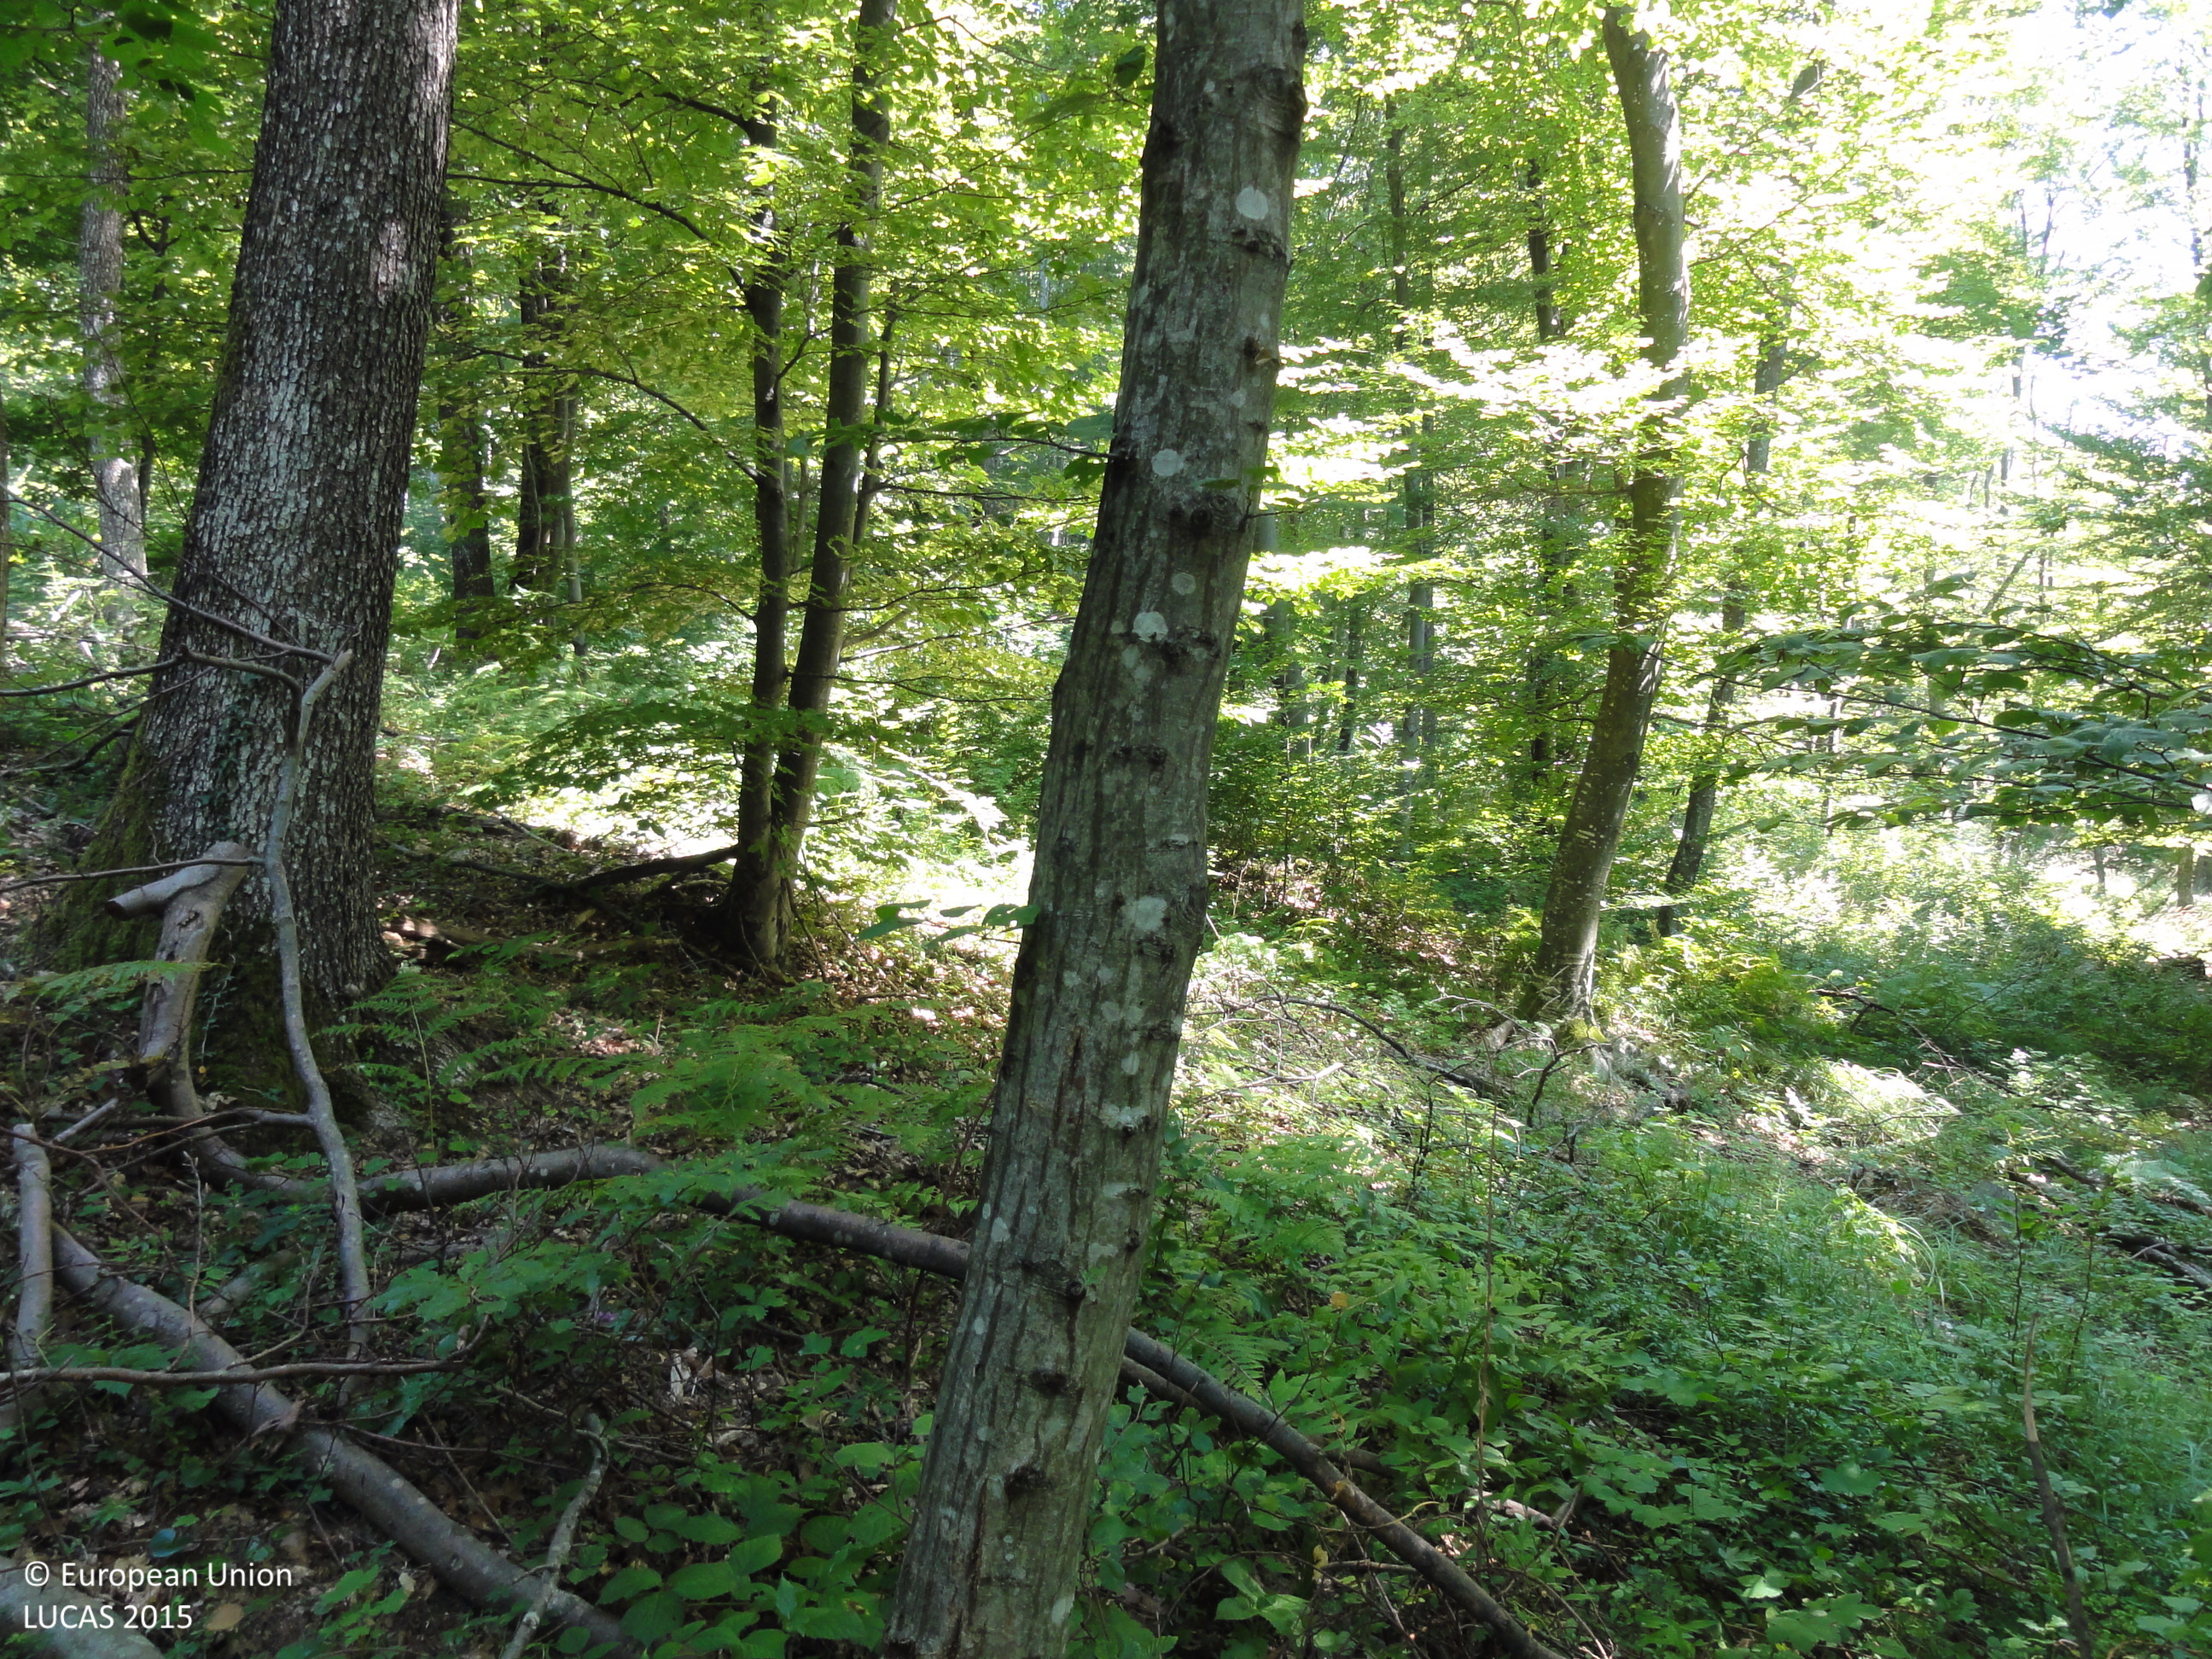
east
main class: Woodland
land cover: Broadleaved woodland
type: beech forest
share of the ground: > 75 %
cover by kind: broadleaved forest trees 100 %
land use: Forestry
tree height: > 5 m
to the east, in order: Broadleaved woodland; Tracks; Broadleaved woodland; Shrubland without tree cover; Tracks; Broadleaved woodland
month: August
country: SI
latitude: 45.9988
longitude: 15.0197
